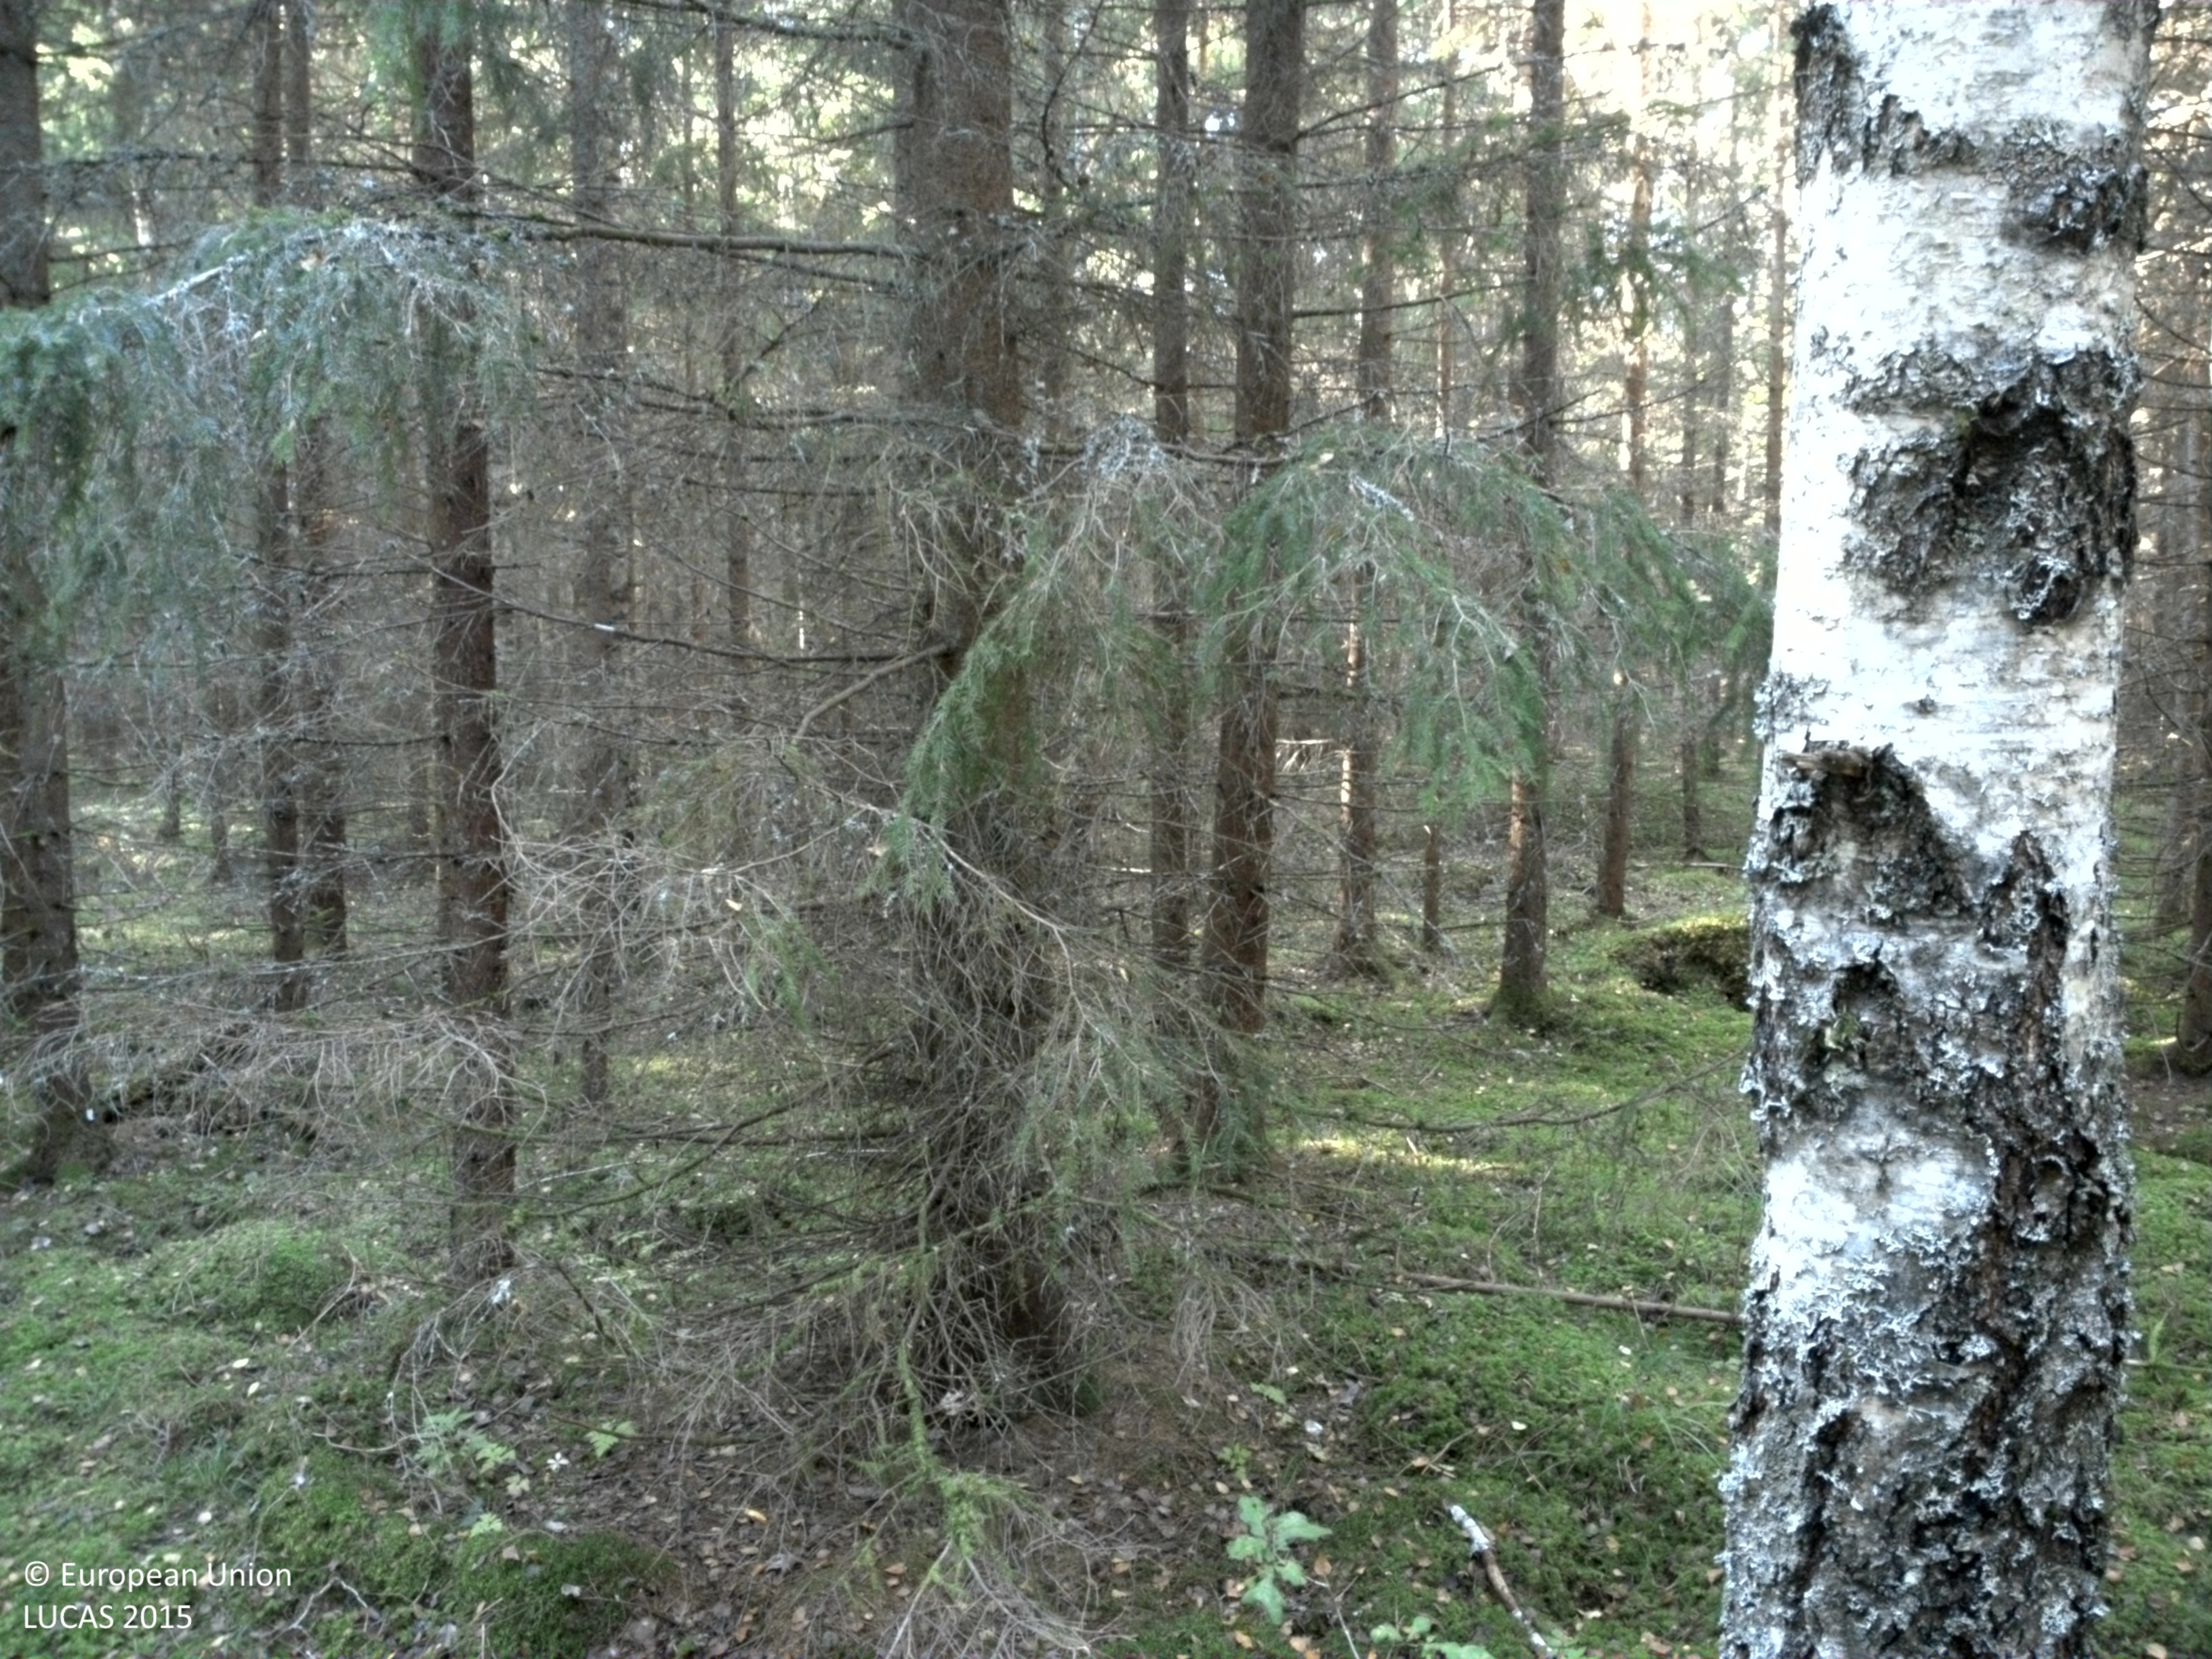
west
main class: Woodland
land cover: Spruce dominated mixed woodland
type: boreal forest
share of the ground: 10 - 25 %
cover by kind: lichens and mosses 65 %, coniferous forest trees 15 %, broadleaved forest trees 10 %, herbaceous plants 10 %
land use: Forestry
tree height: > 5 m
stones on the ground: 10 - 25 %
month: September
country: SE
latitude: 59.0950
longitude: 14.0594
